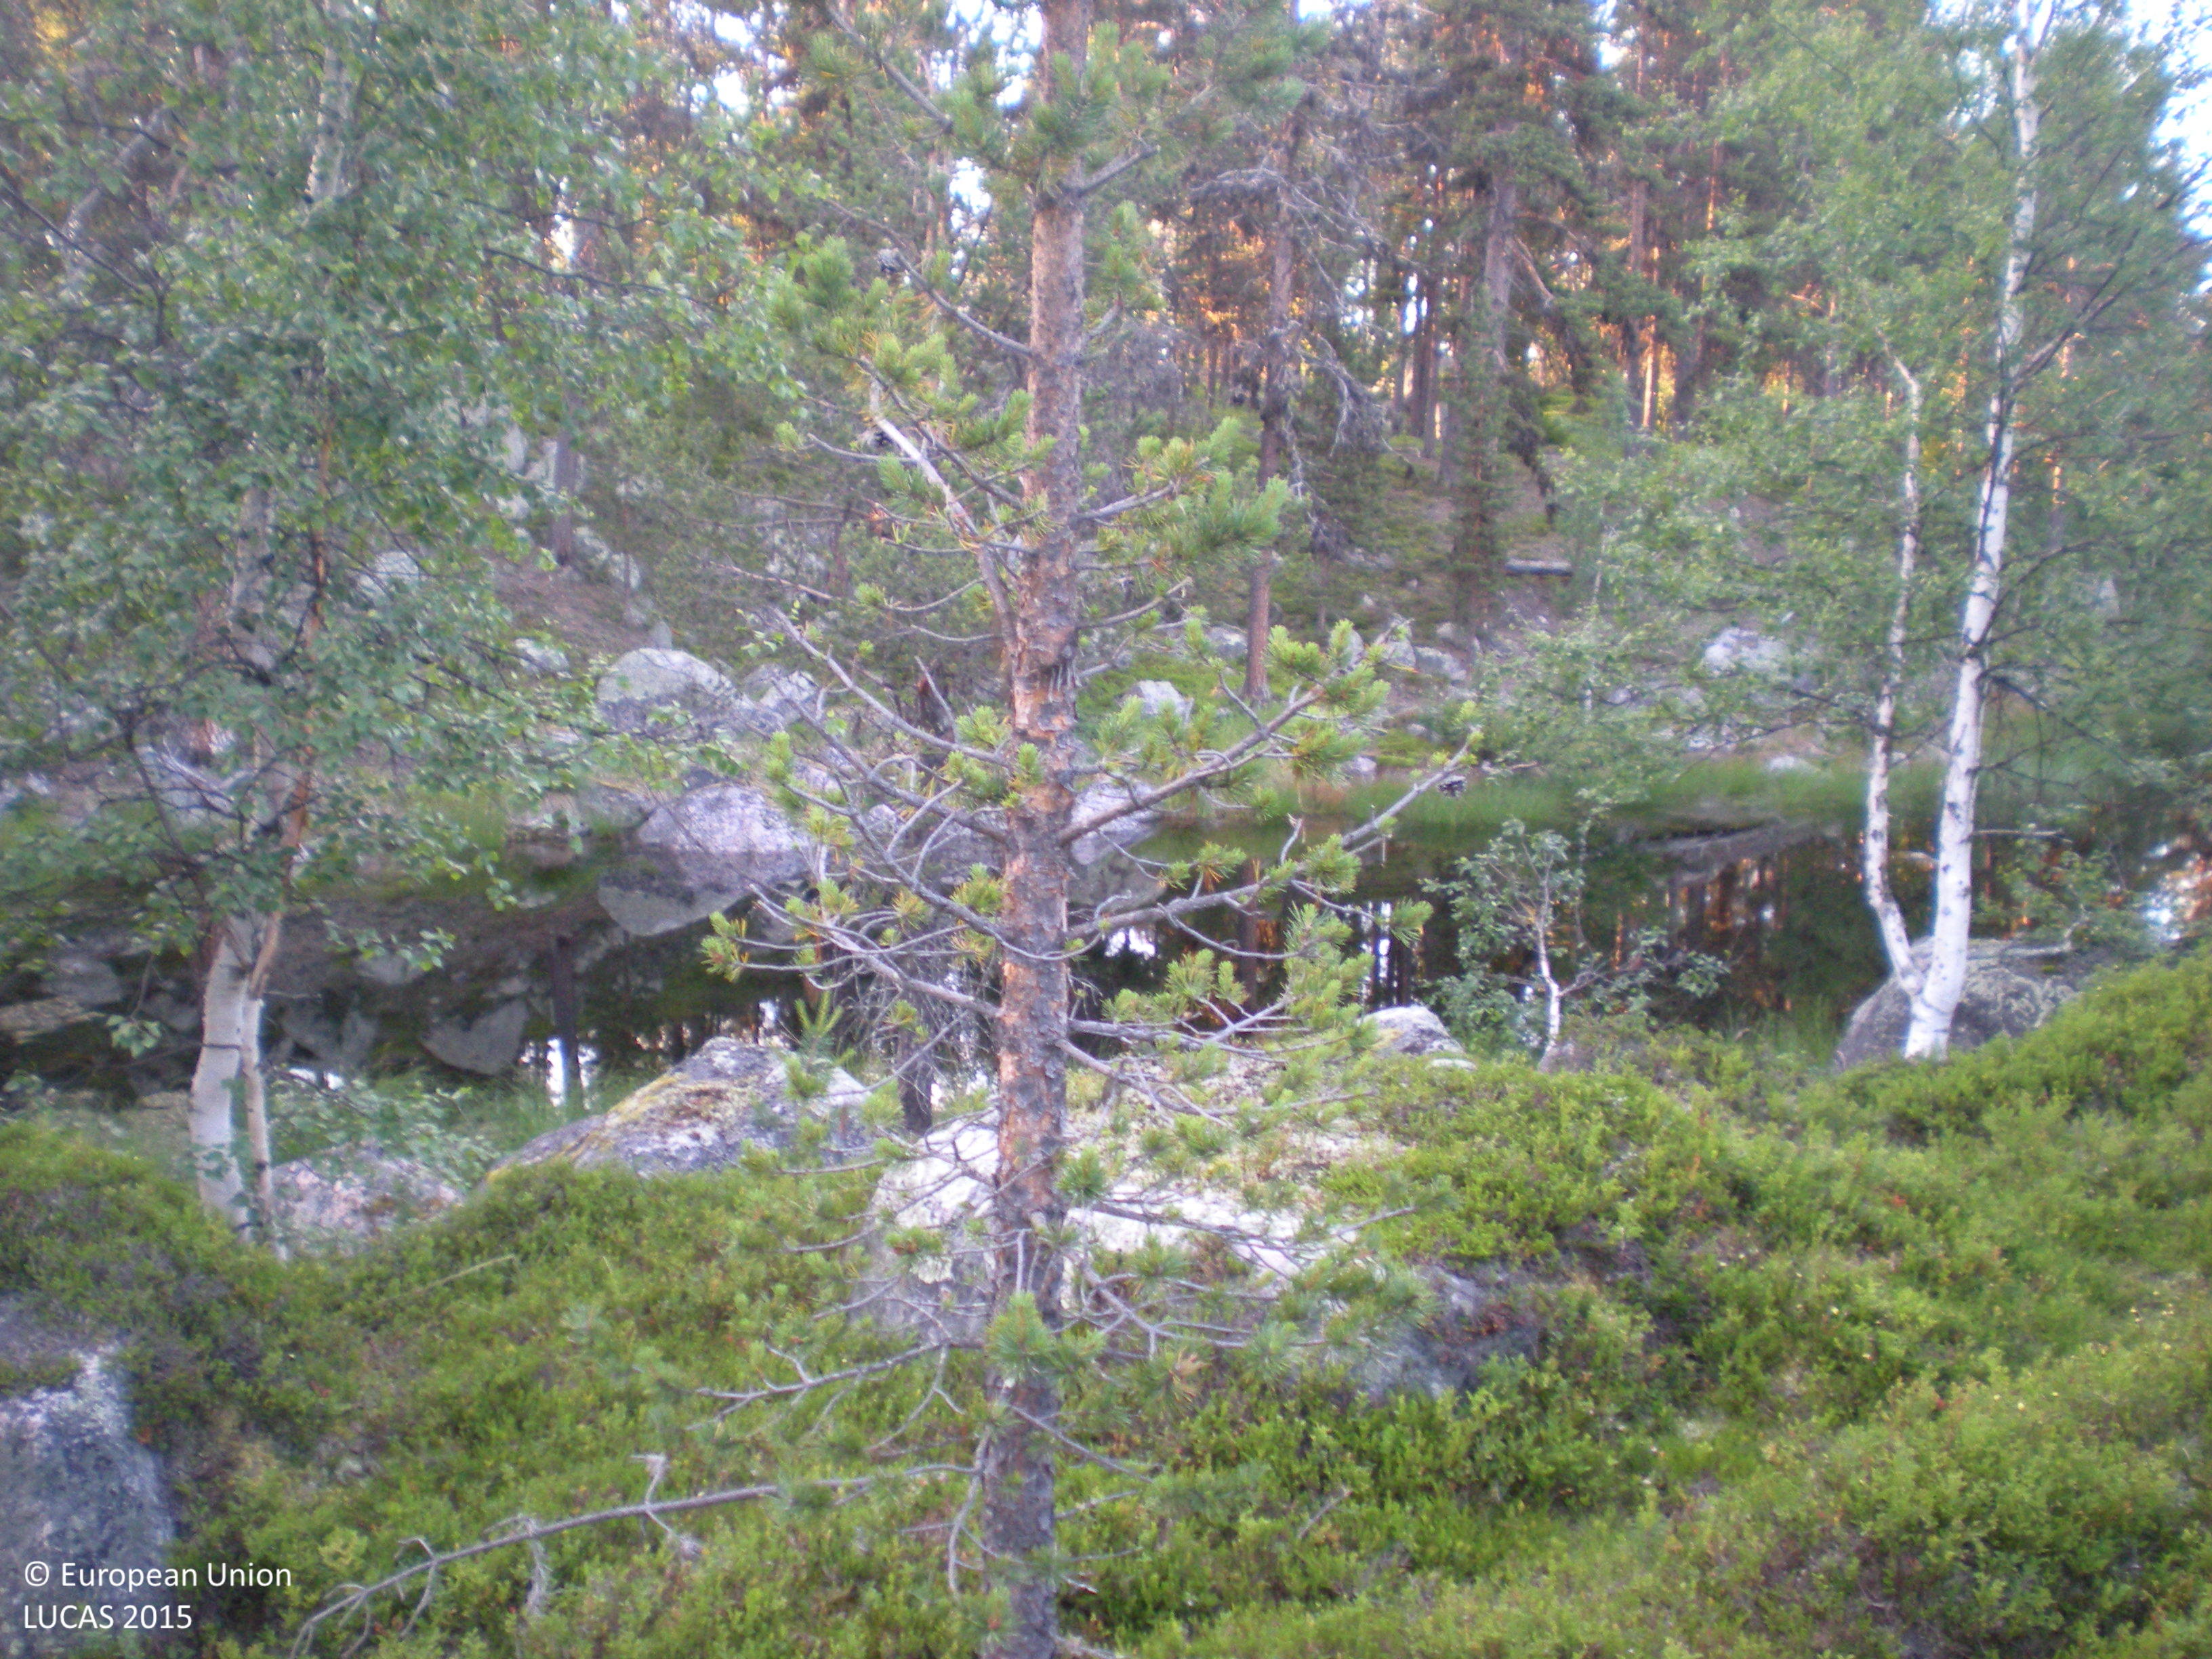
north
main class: Woodland
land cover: Pine dominated mixed woodland
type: boreal forest
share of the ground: 25 - 50 %
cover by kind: coniferous forest trees 30 %, shrubs 30 %, broadleaved forest trees 20 %, lichens and mosses 10 %, consolidated bare surface 10 %
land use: Forestry
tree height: > 5 m
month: August
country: SE
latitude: 66.2514
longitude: 17.9866
